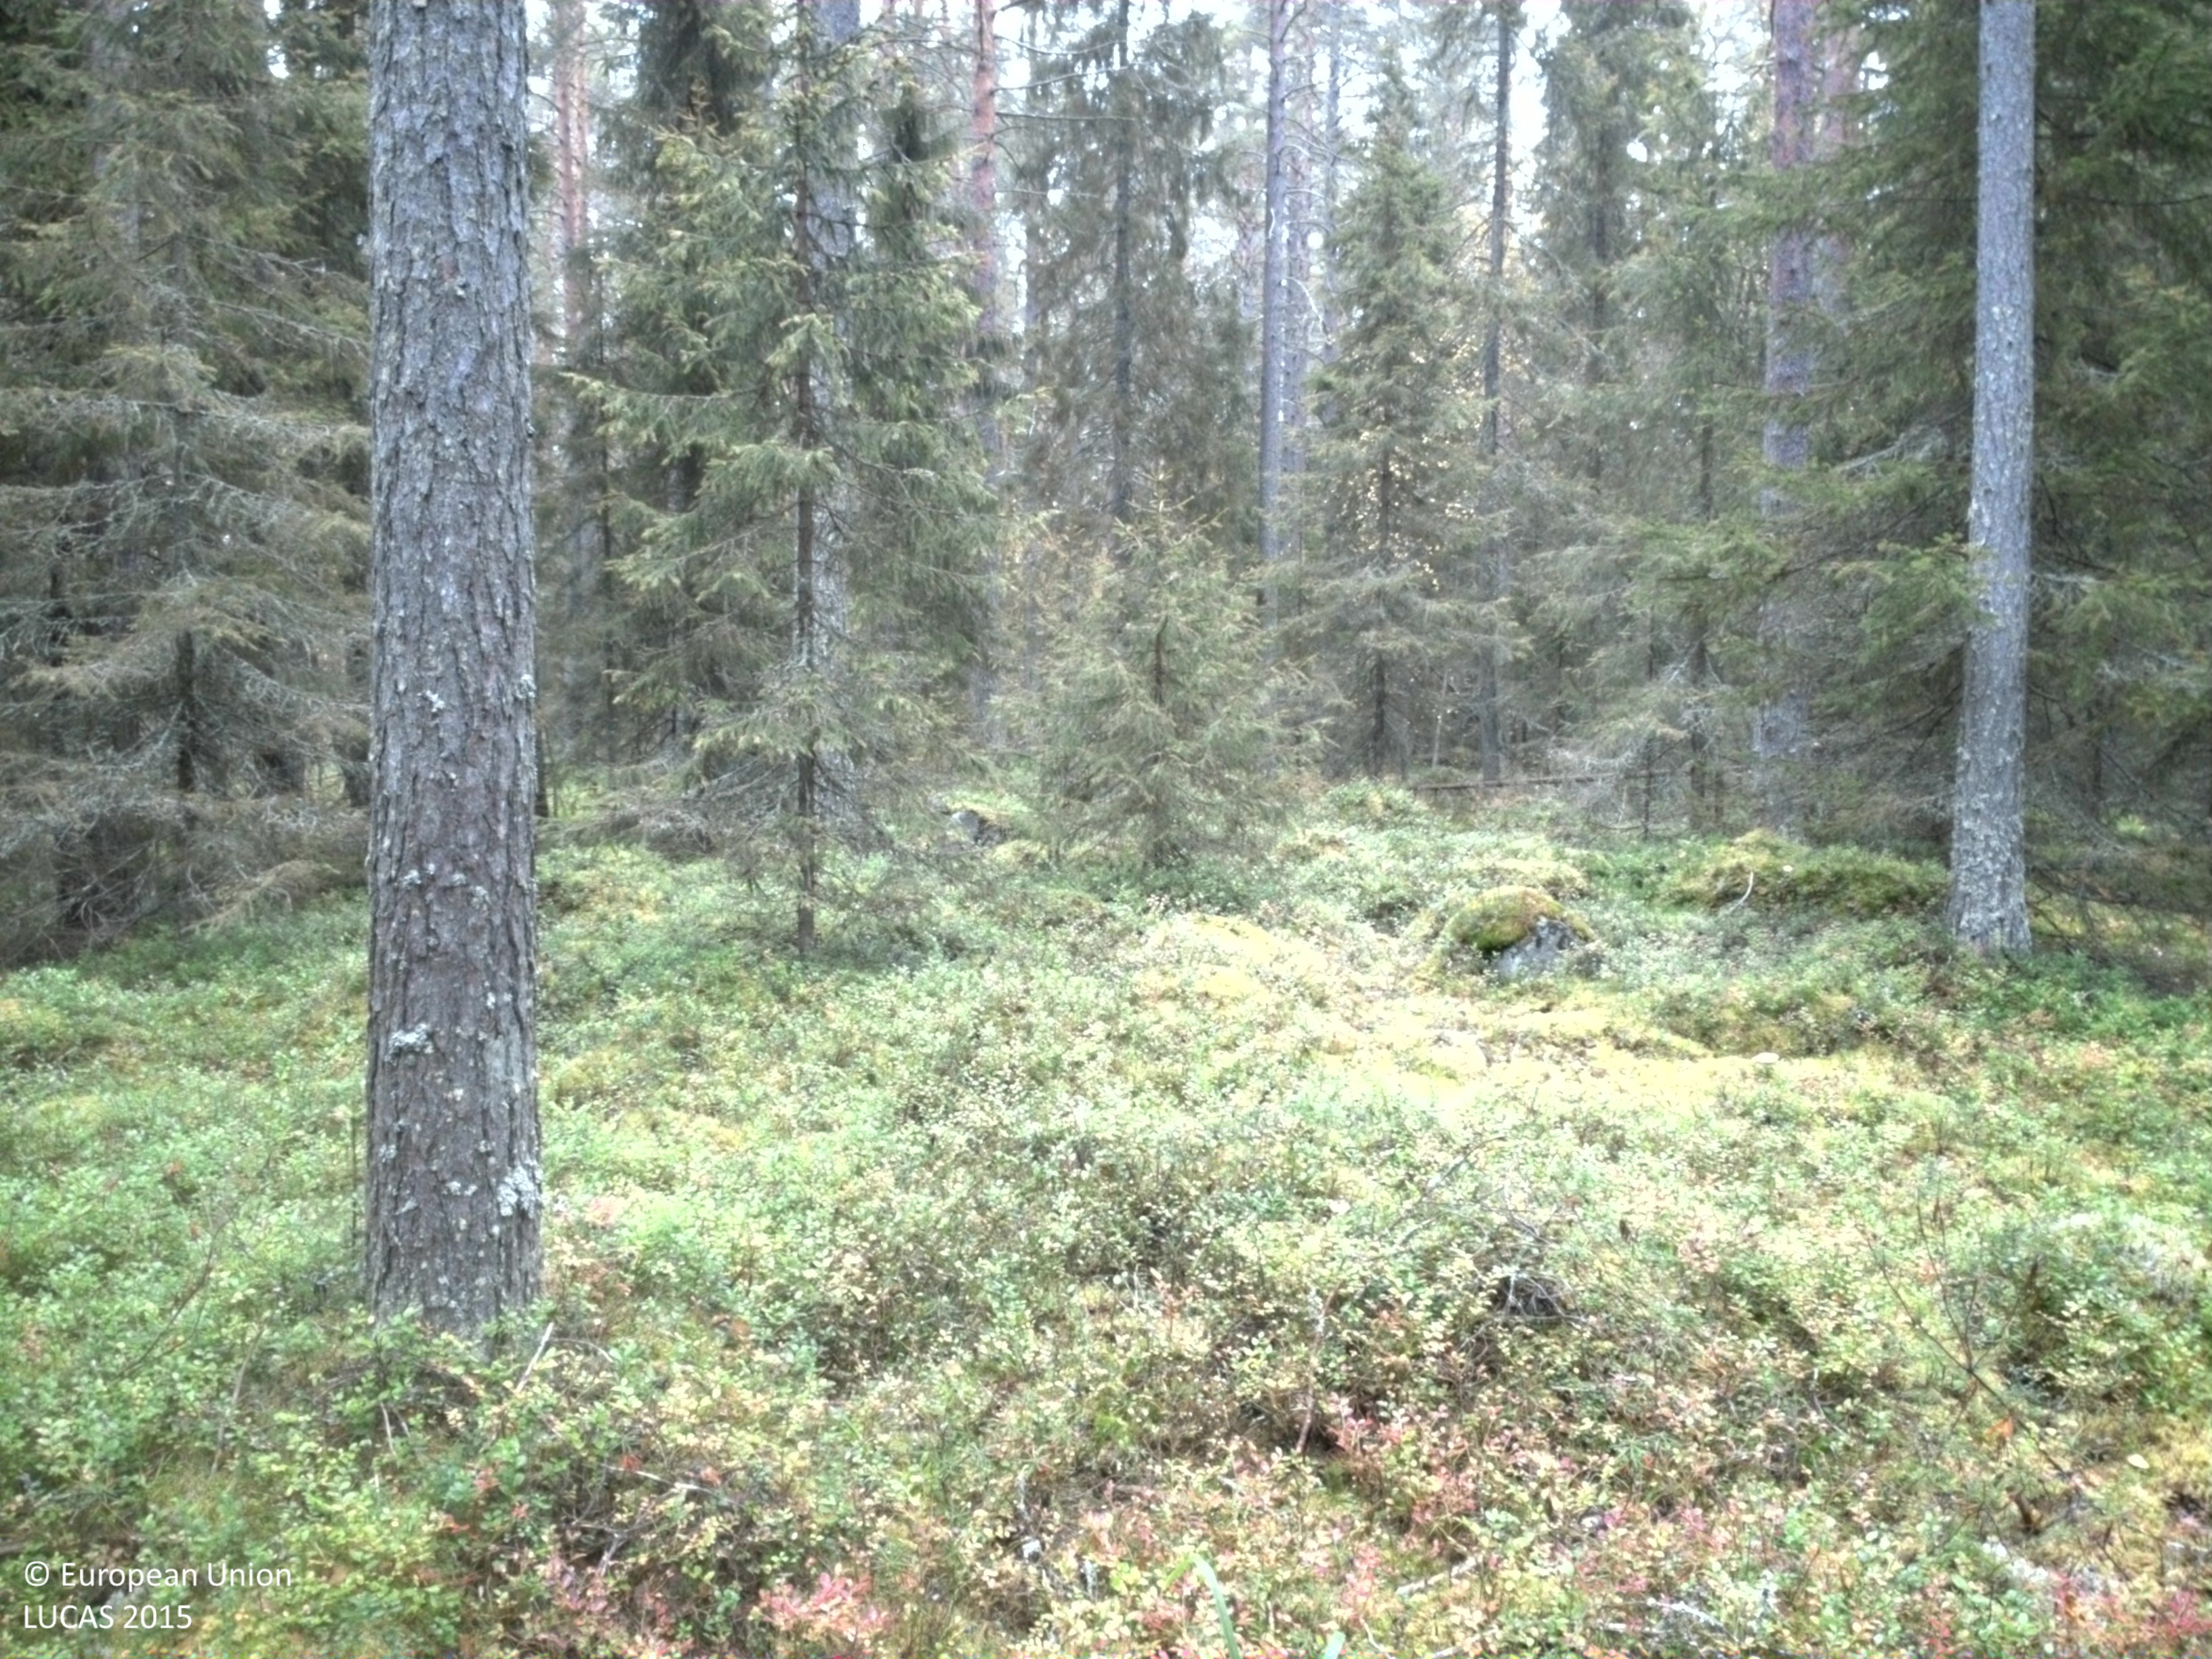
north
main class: Woodland
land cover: Pine dominated coniferous woodland
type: boreal forest
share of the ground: 25 - 50 %
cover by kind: shrubs 55 %, coniferous forest trees 35 %, broadleaved forest trees 5 %, lichens and mosses 5 %
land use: Forestry
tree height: > 5 m
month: September
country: SE
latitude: 65.8293
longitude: 21.9911
